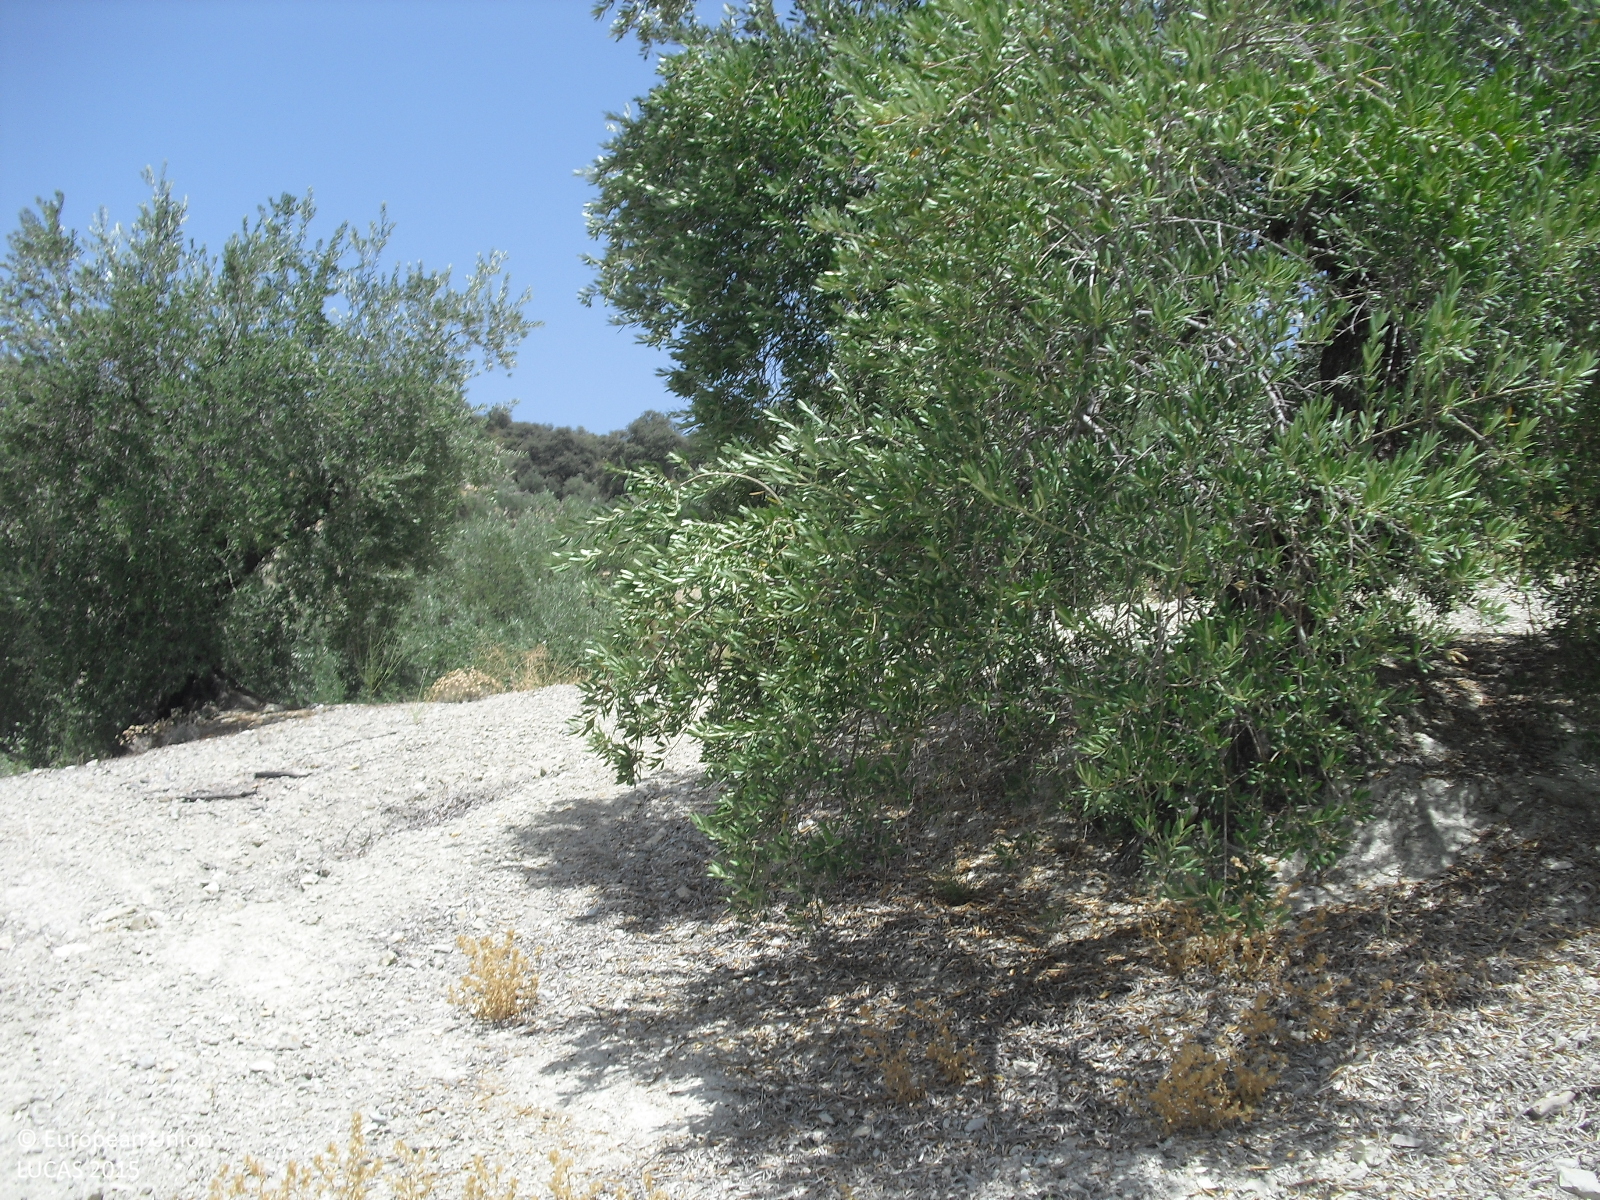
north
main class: Cropland
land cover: Olive groves
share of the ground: 25 - 50 %
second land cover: Other bare soil
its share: > 75 %
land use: Agriculture (excluding fallow land and kitchen gardens)
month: August
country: ES
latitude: 37.3576
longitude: -4.1900
